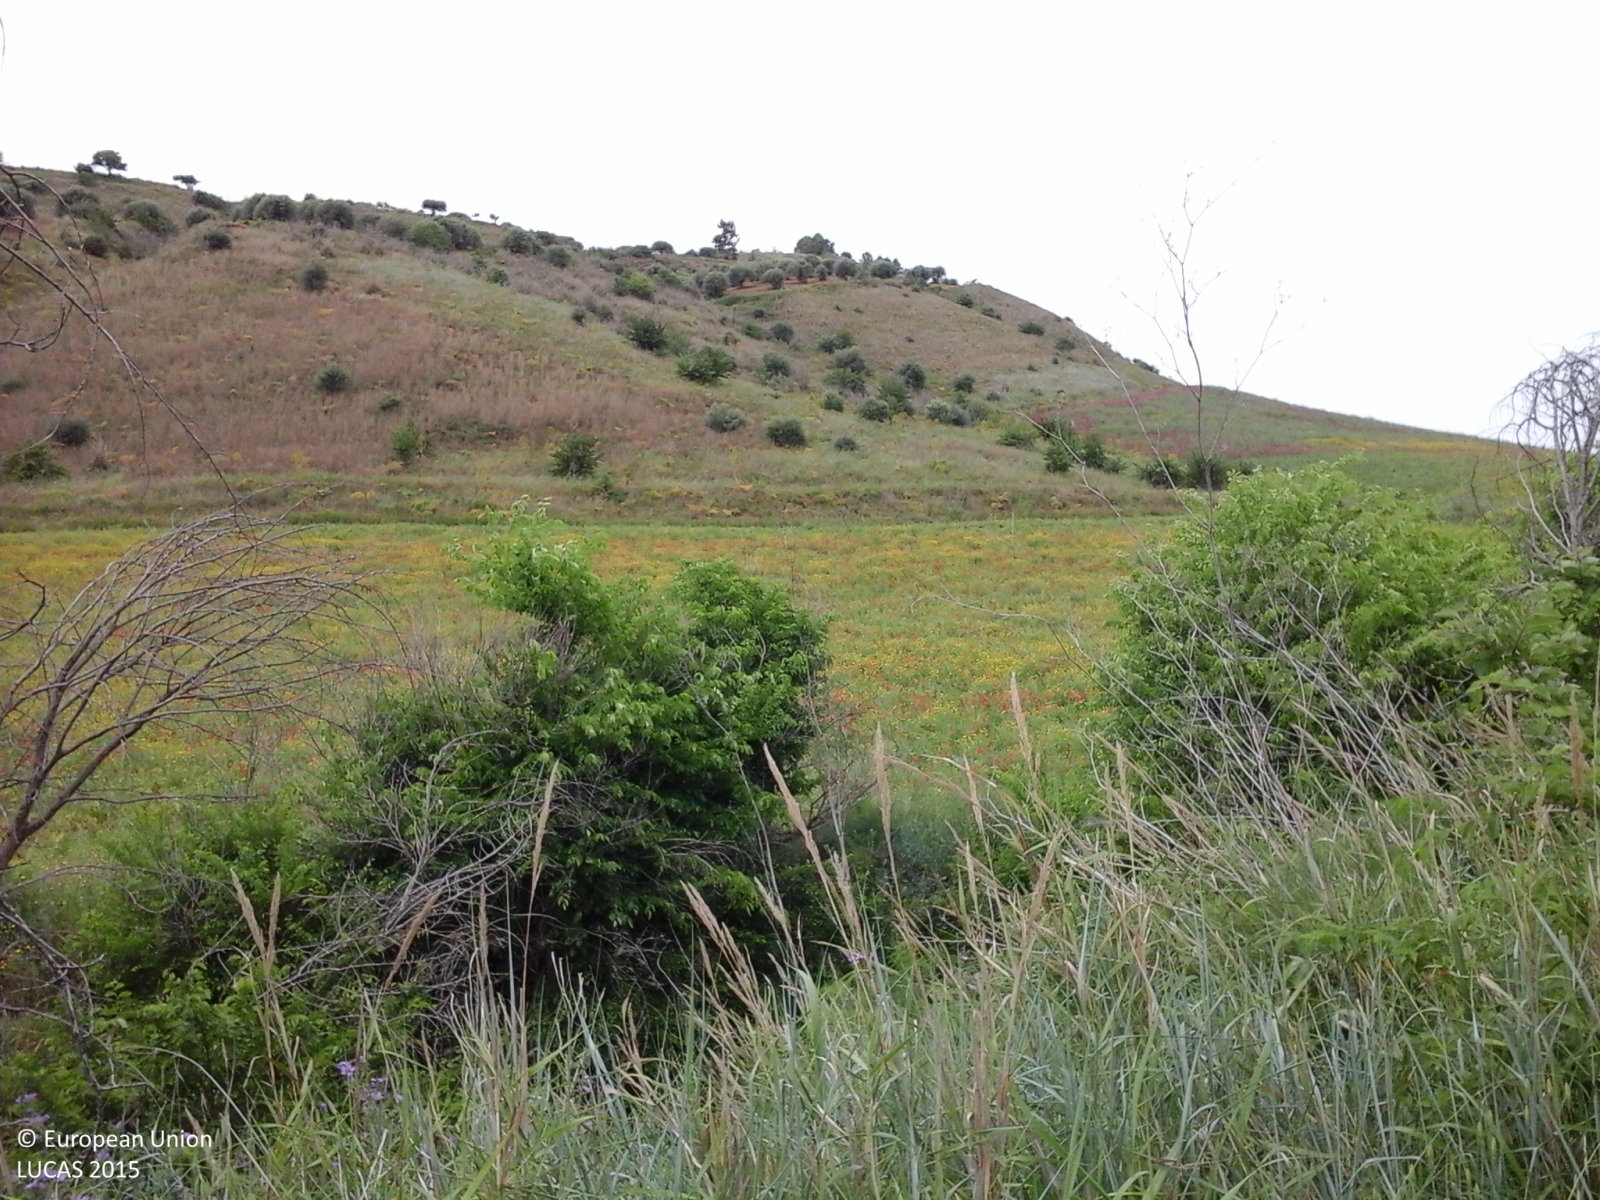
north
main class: Grassland
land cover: Spontaneously vegetated surfaces
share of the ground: > 75 %
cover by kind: herbaceous plants 100 %
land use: Agriculture (excluding fallow land and kitchen gardens)
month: May
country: IT
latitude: 37.6645
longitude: 13.9727
